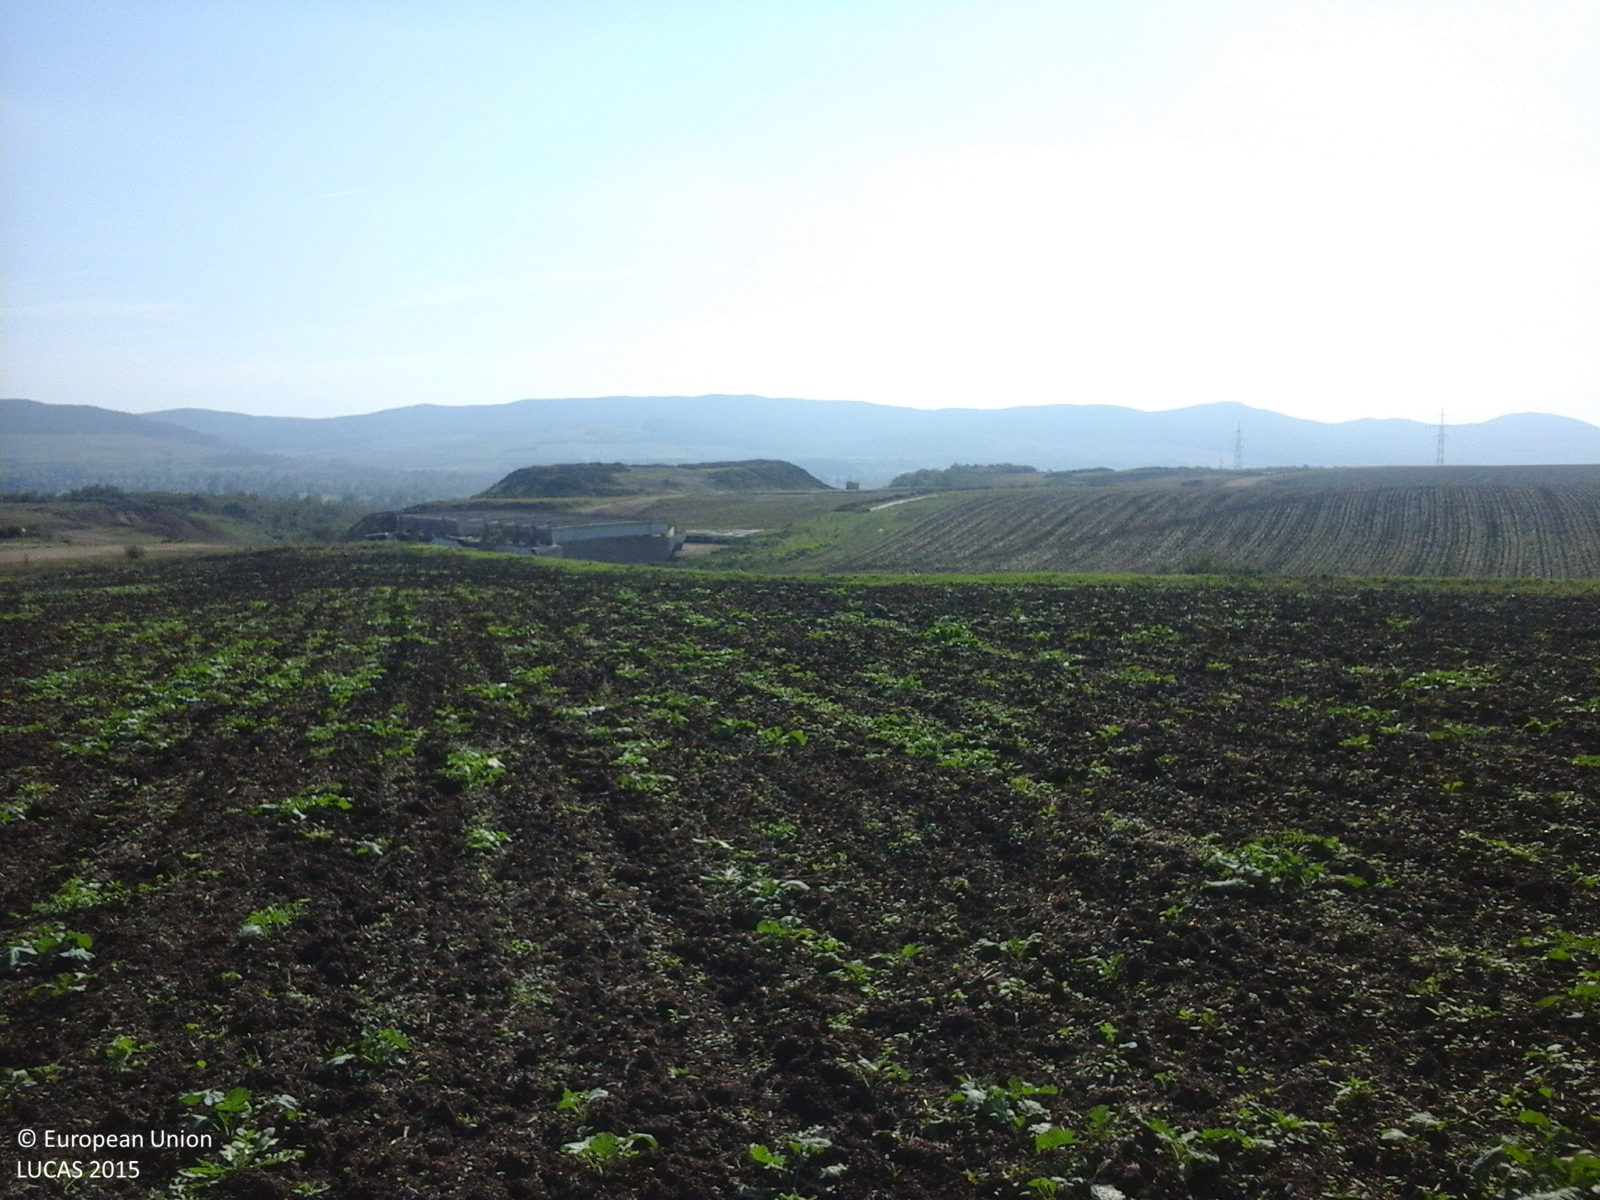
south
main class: Cropland
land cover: Common wheat
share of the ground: < 10 %
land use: Agriculture (excluding fallow land and kitchen gardens)
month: October
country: RO
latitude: 46.4018
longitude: 23.7946
